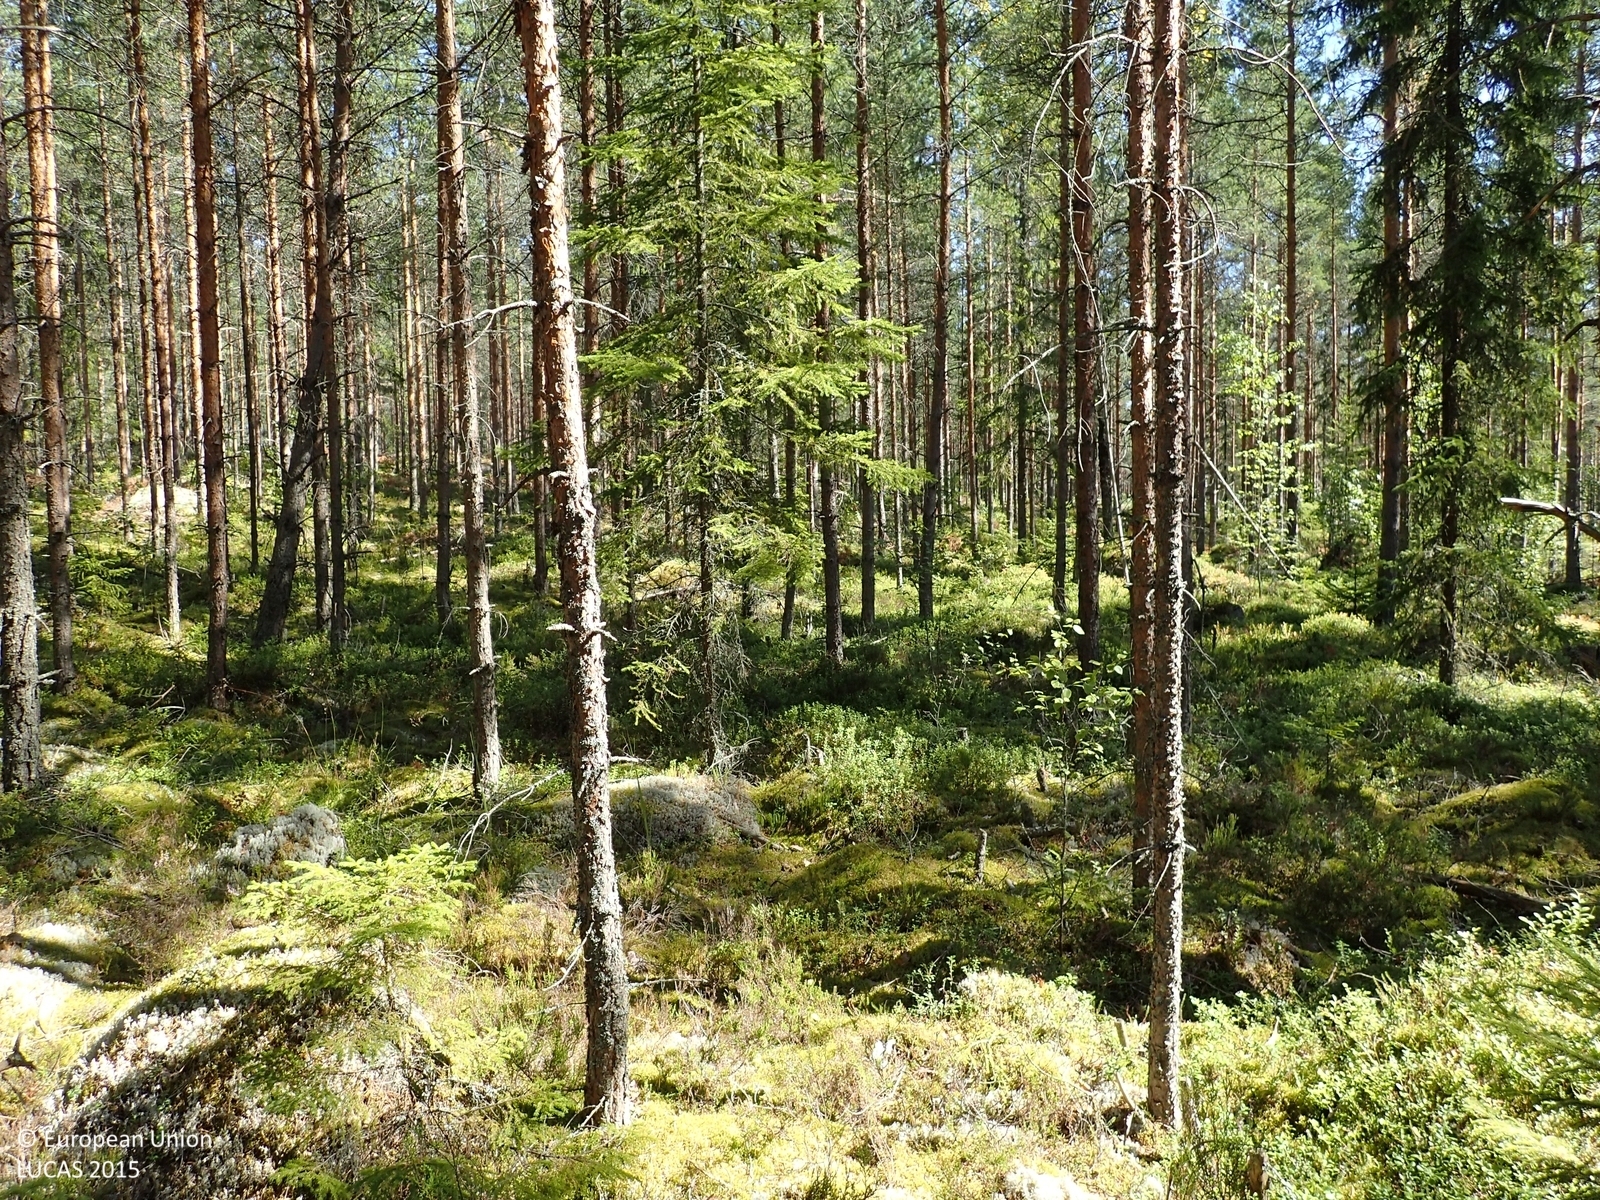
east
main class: Woodland
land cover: Pine dominated coniferous woodland
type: boreal forest
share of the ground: 50 - 75 %
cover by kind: coniferous forest trees 55 %, shrubs 25 %, lichens and mosses 15 %, broadleaved forest trees 5 %
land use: Forestry
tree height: > 5 m
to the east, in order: Pine dominated coniferous woodland; Tracks; Pine dominated coniferous woodland
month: August
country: FI
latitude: 62.5418
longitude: 22.5559
